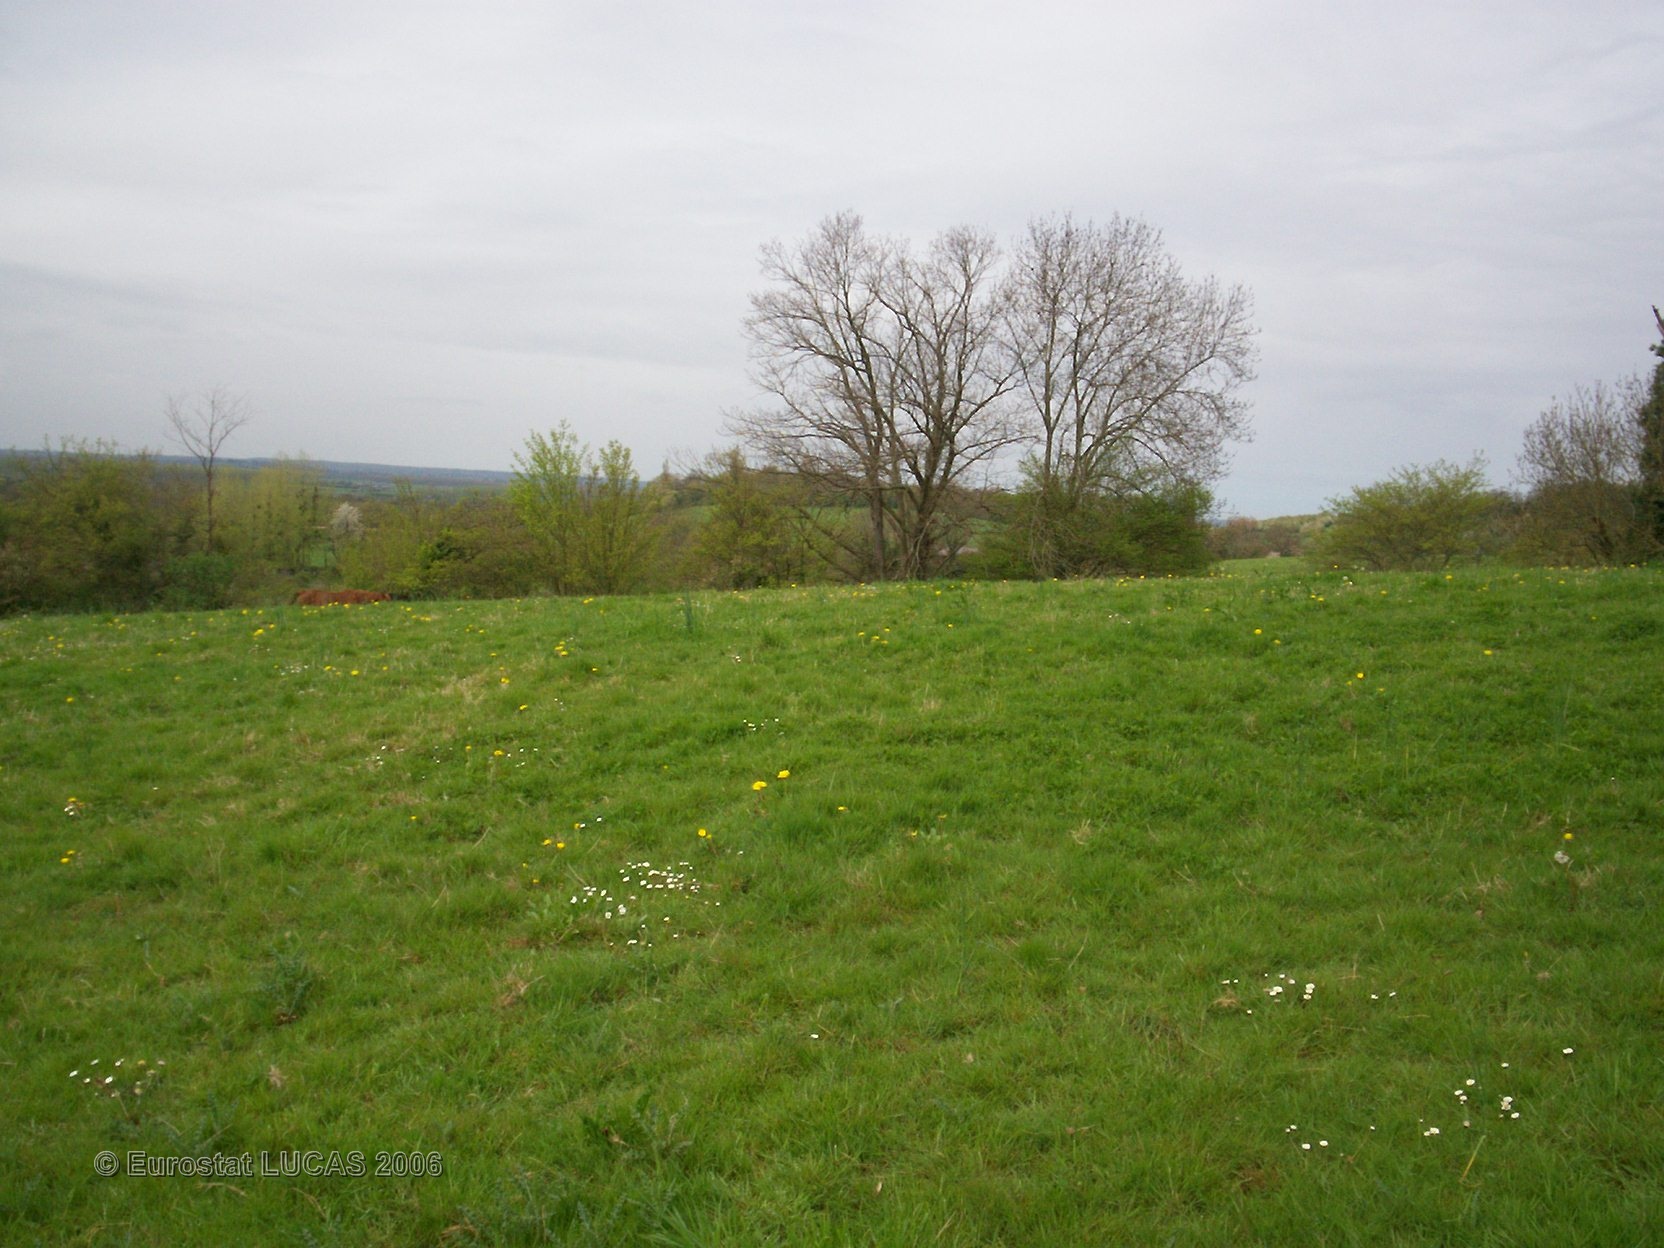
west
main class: Grassland
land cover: Grassland without tree/shrub cover
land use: Agriculture (excluding fallow land and kitchen gardens)
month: April
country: FR
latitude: 49.1966
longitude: -0.0356
